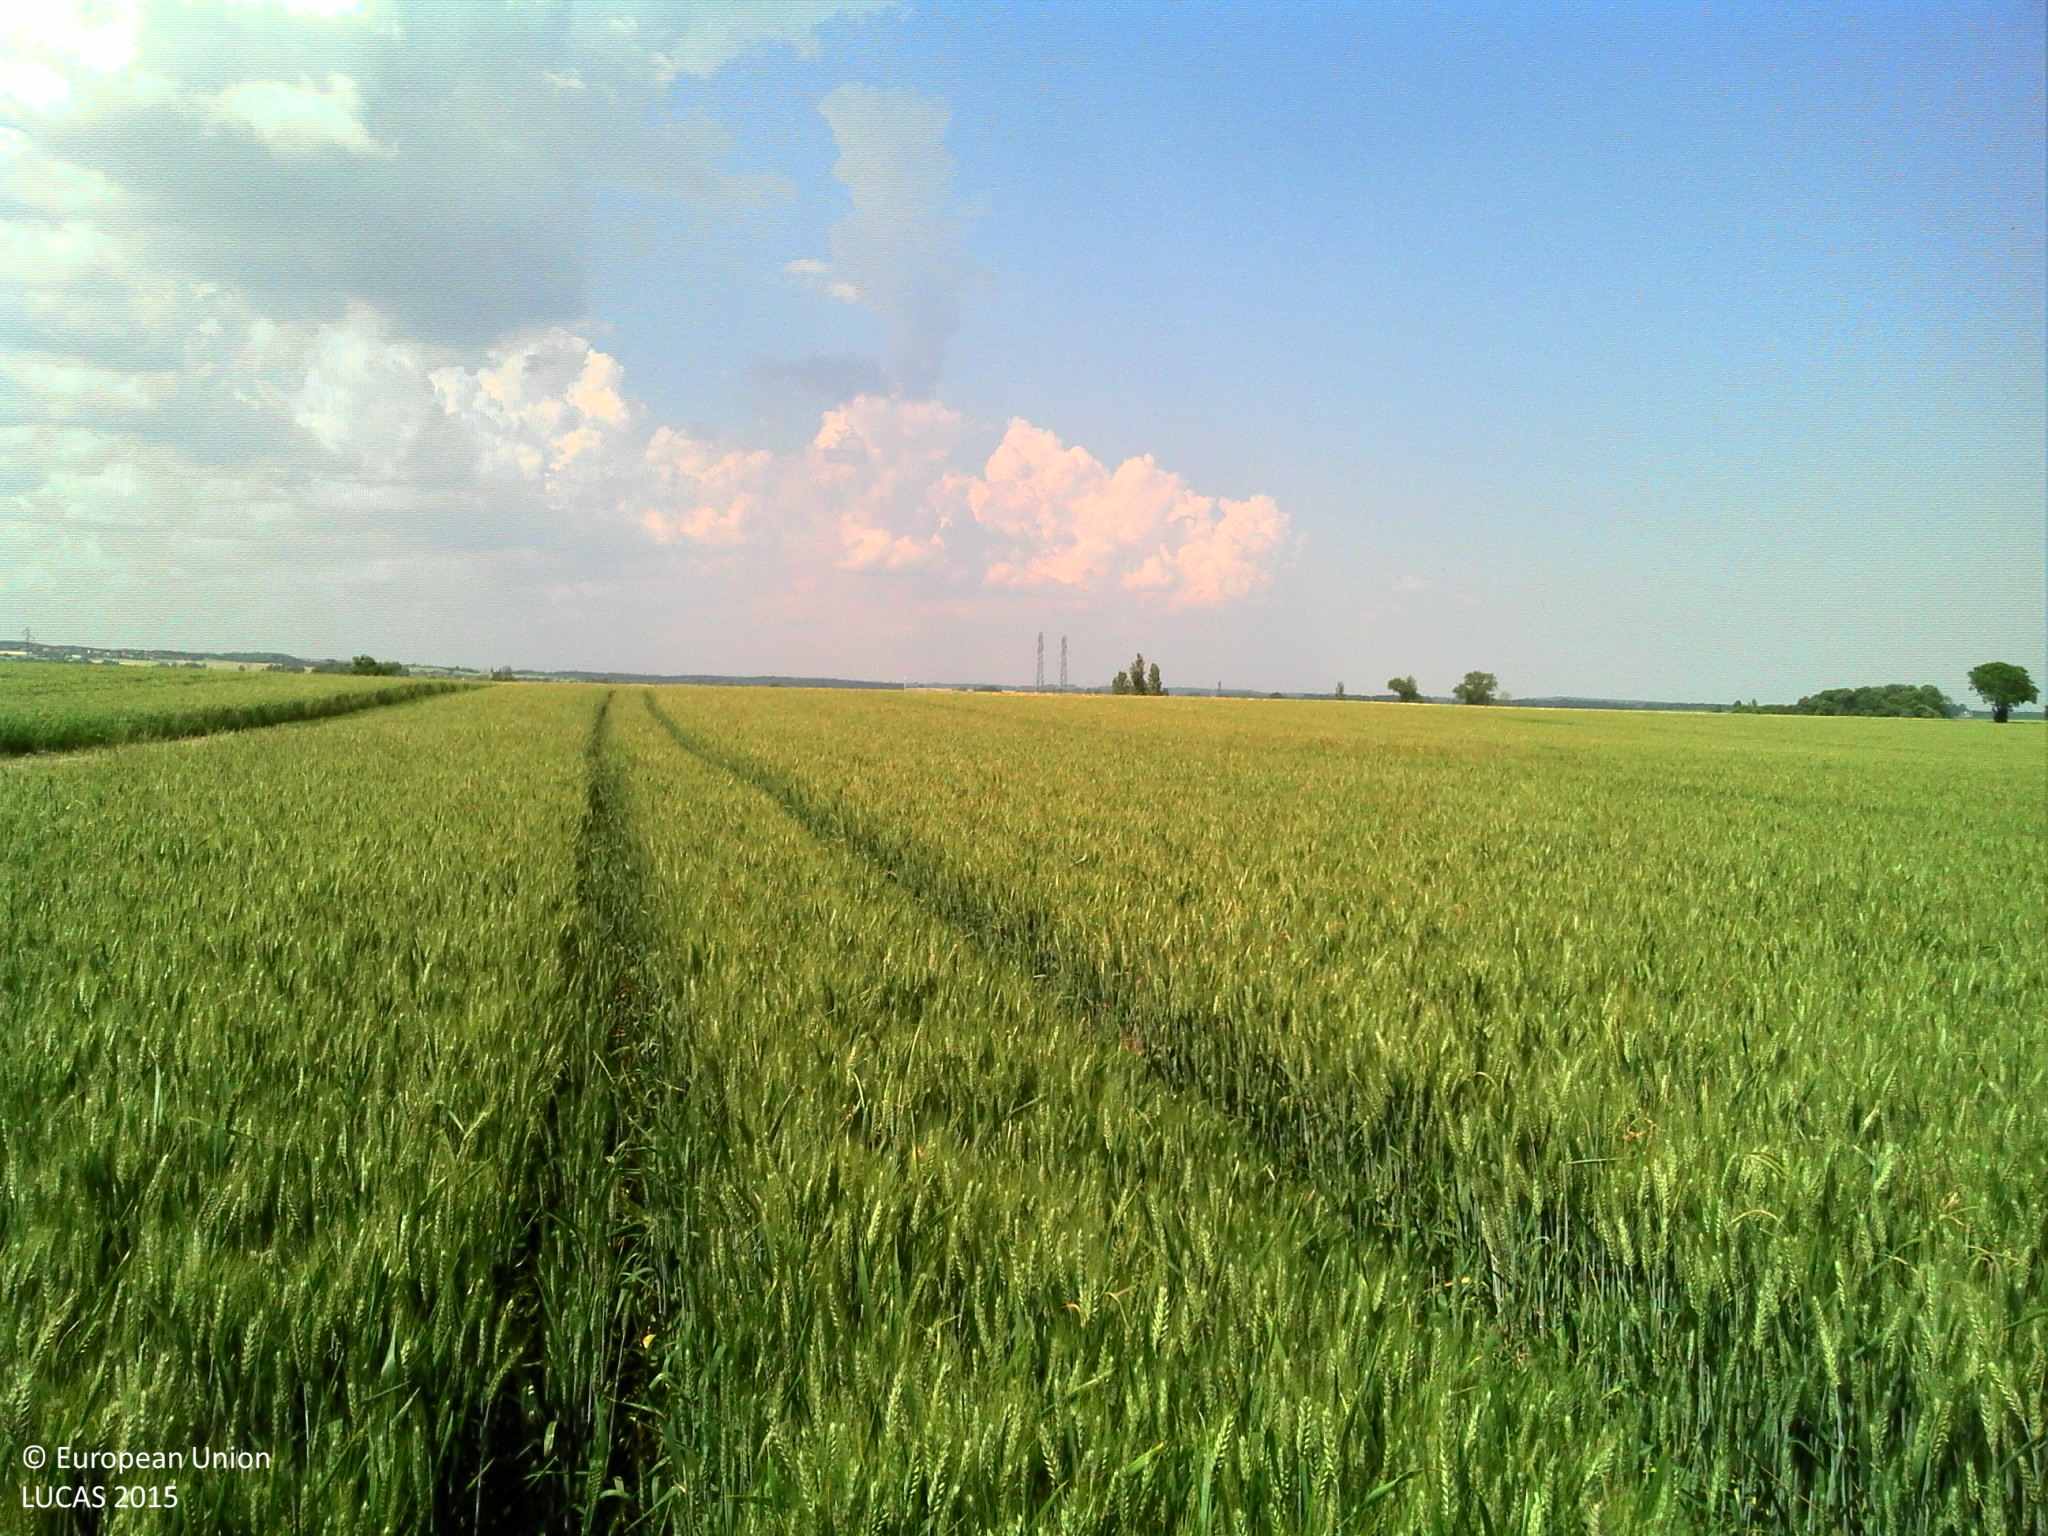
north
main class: Cropland
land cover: Common wheat
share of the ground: > 75 %
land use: Agriculture (excluding fallow land and kitchen gardens)
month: June
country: FR
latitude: 47.3389
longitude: 5.0904
